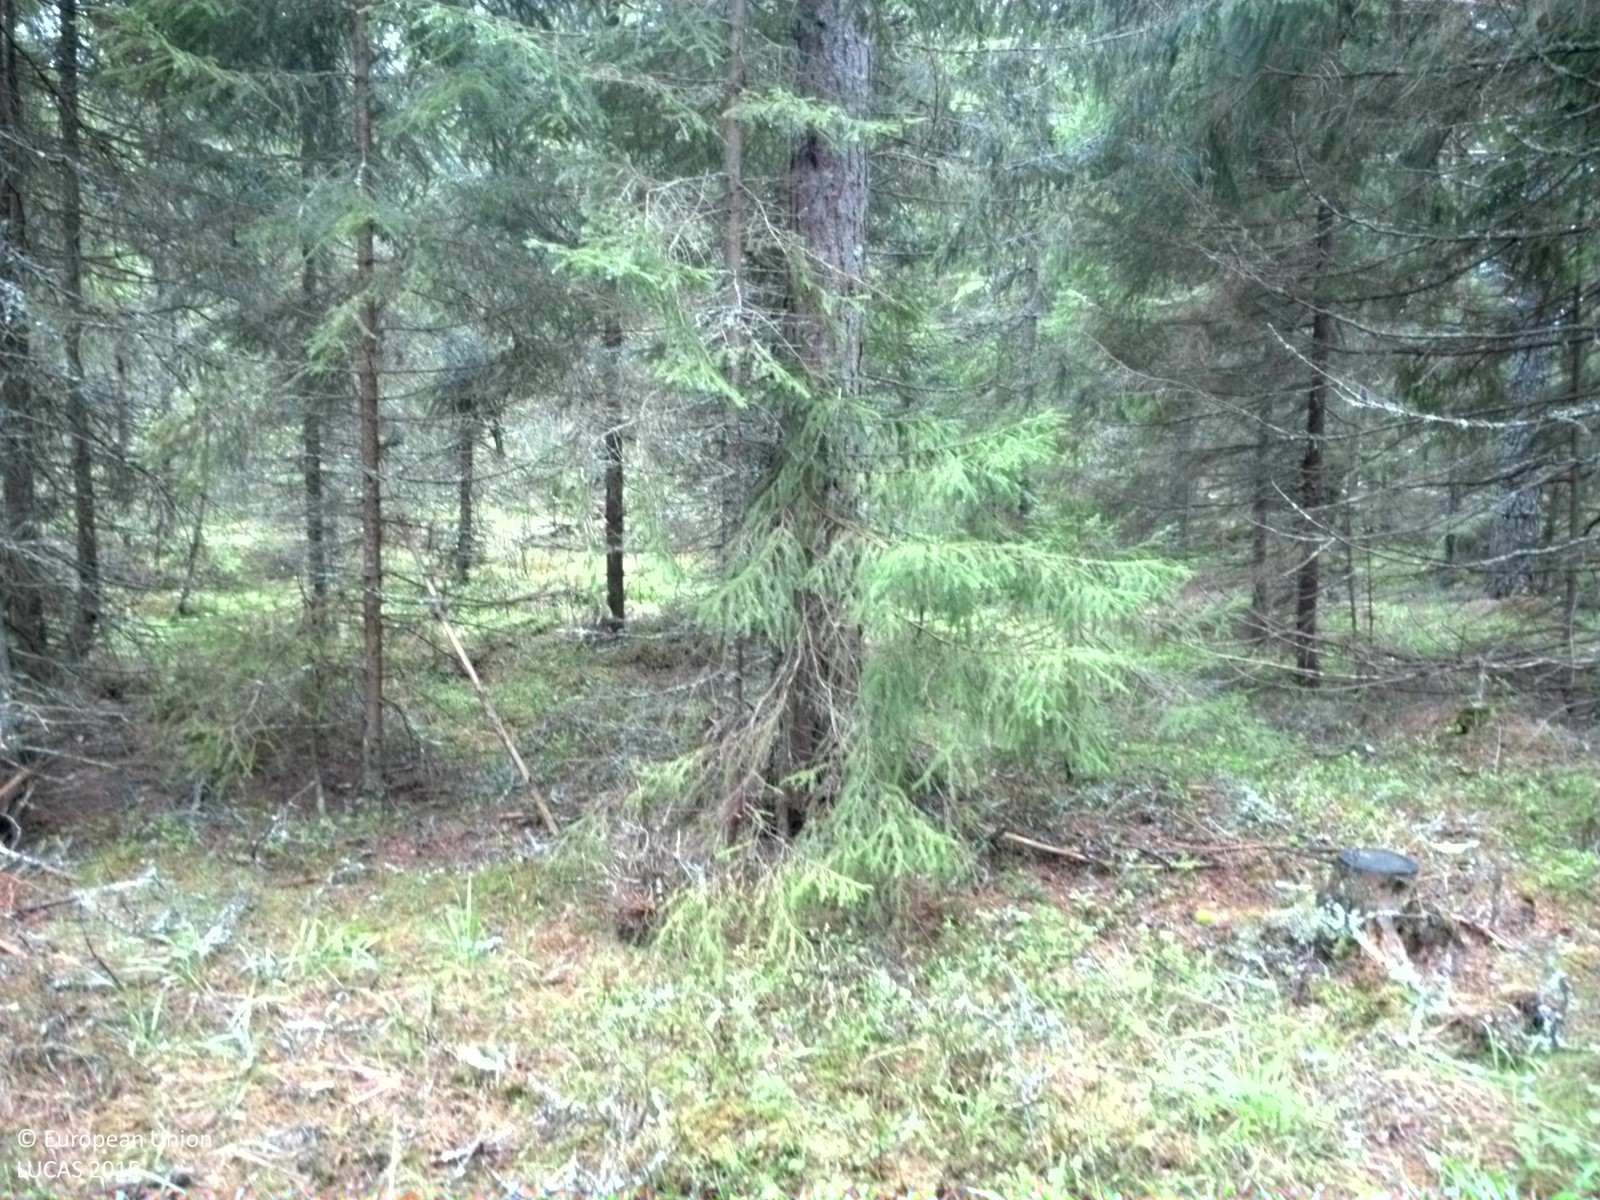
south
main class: Woodland
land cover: Spruce dominated coniferous woodland
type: boreal forest
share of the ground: 50 - 75 %
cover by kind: coniferous forest trees 55 %, herbaceous plants 25 %, shrubs 15 %, lichens and mosses 5 %
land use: Forestry
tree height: > 5 m
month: May
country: SE
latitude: 60.2392
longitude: 18.0674
